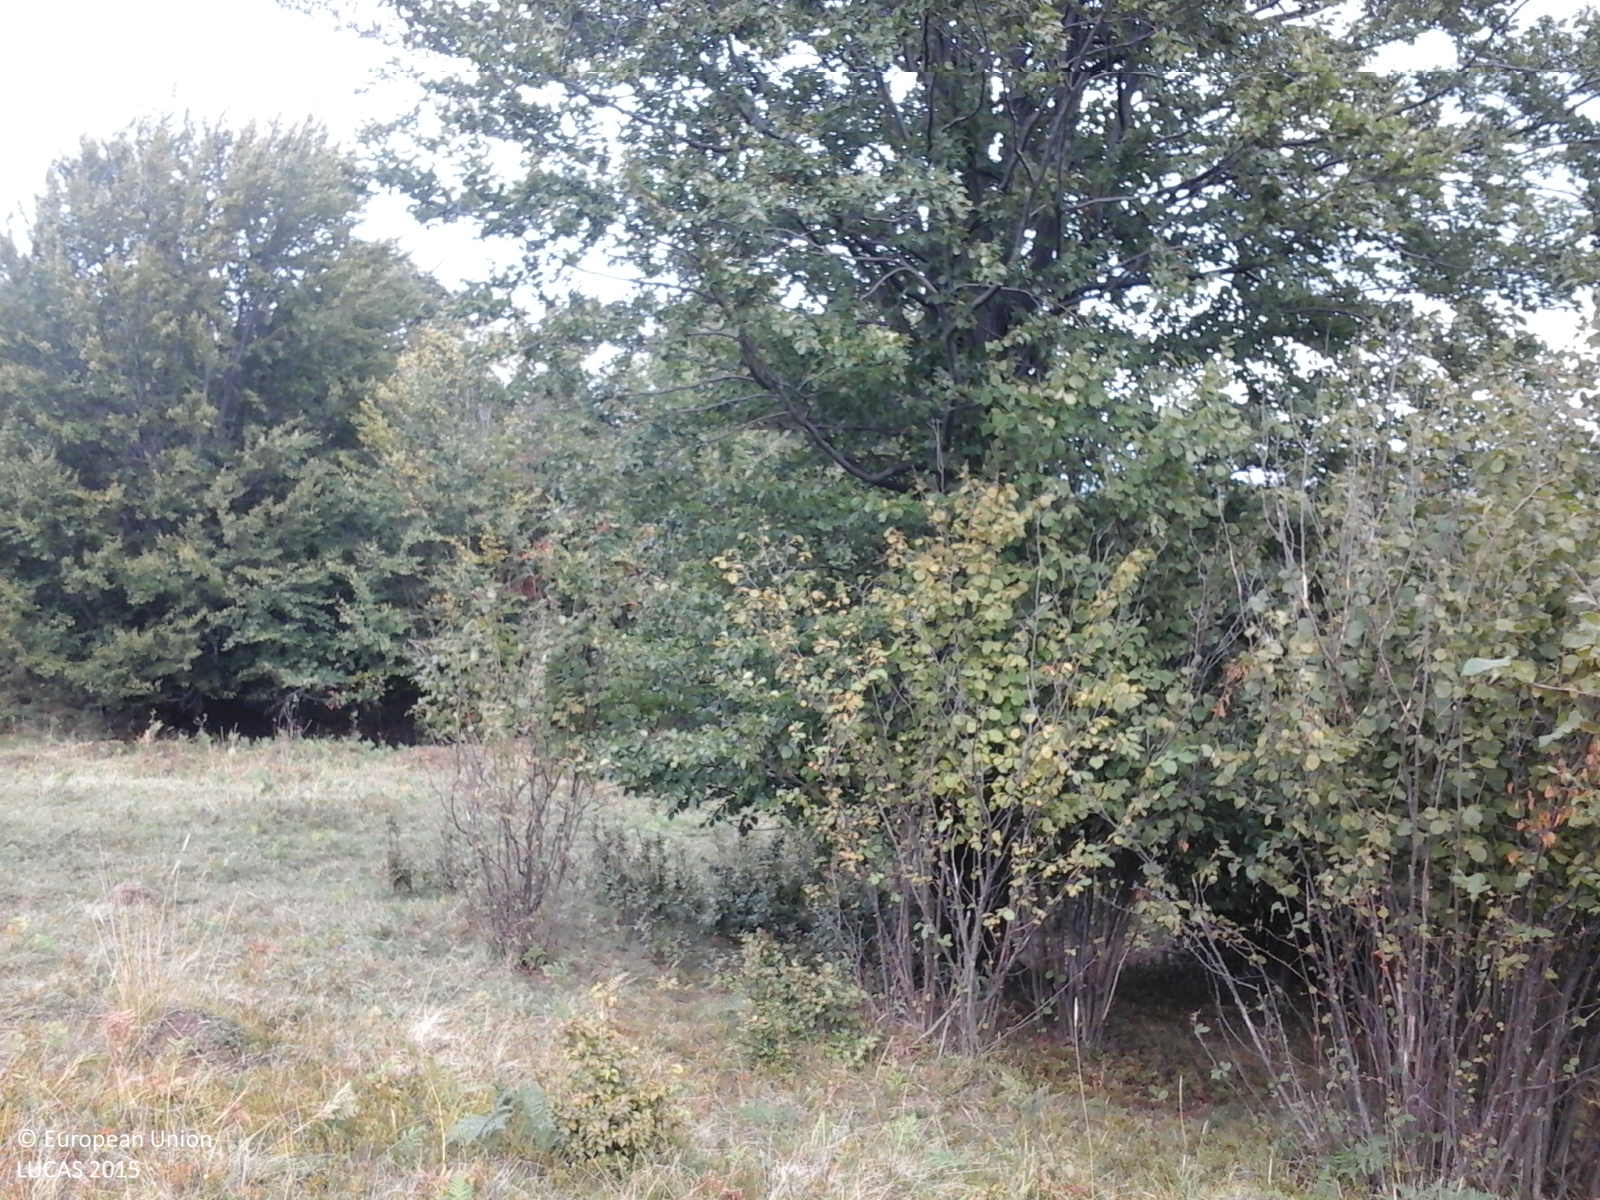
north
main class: Grassland
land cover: Grassland without tree/shrub cover
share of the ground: > 75 %
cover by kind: herbaceous plants 100 %
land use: Agriculture (excluding fallow land and kitchen gardens)
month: September
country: RO
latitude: 47.7025
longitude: 23.9020
